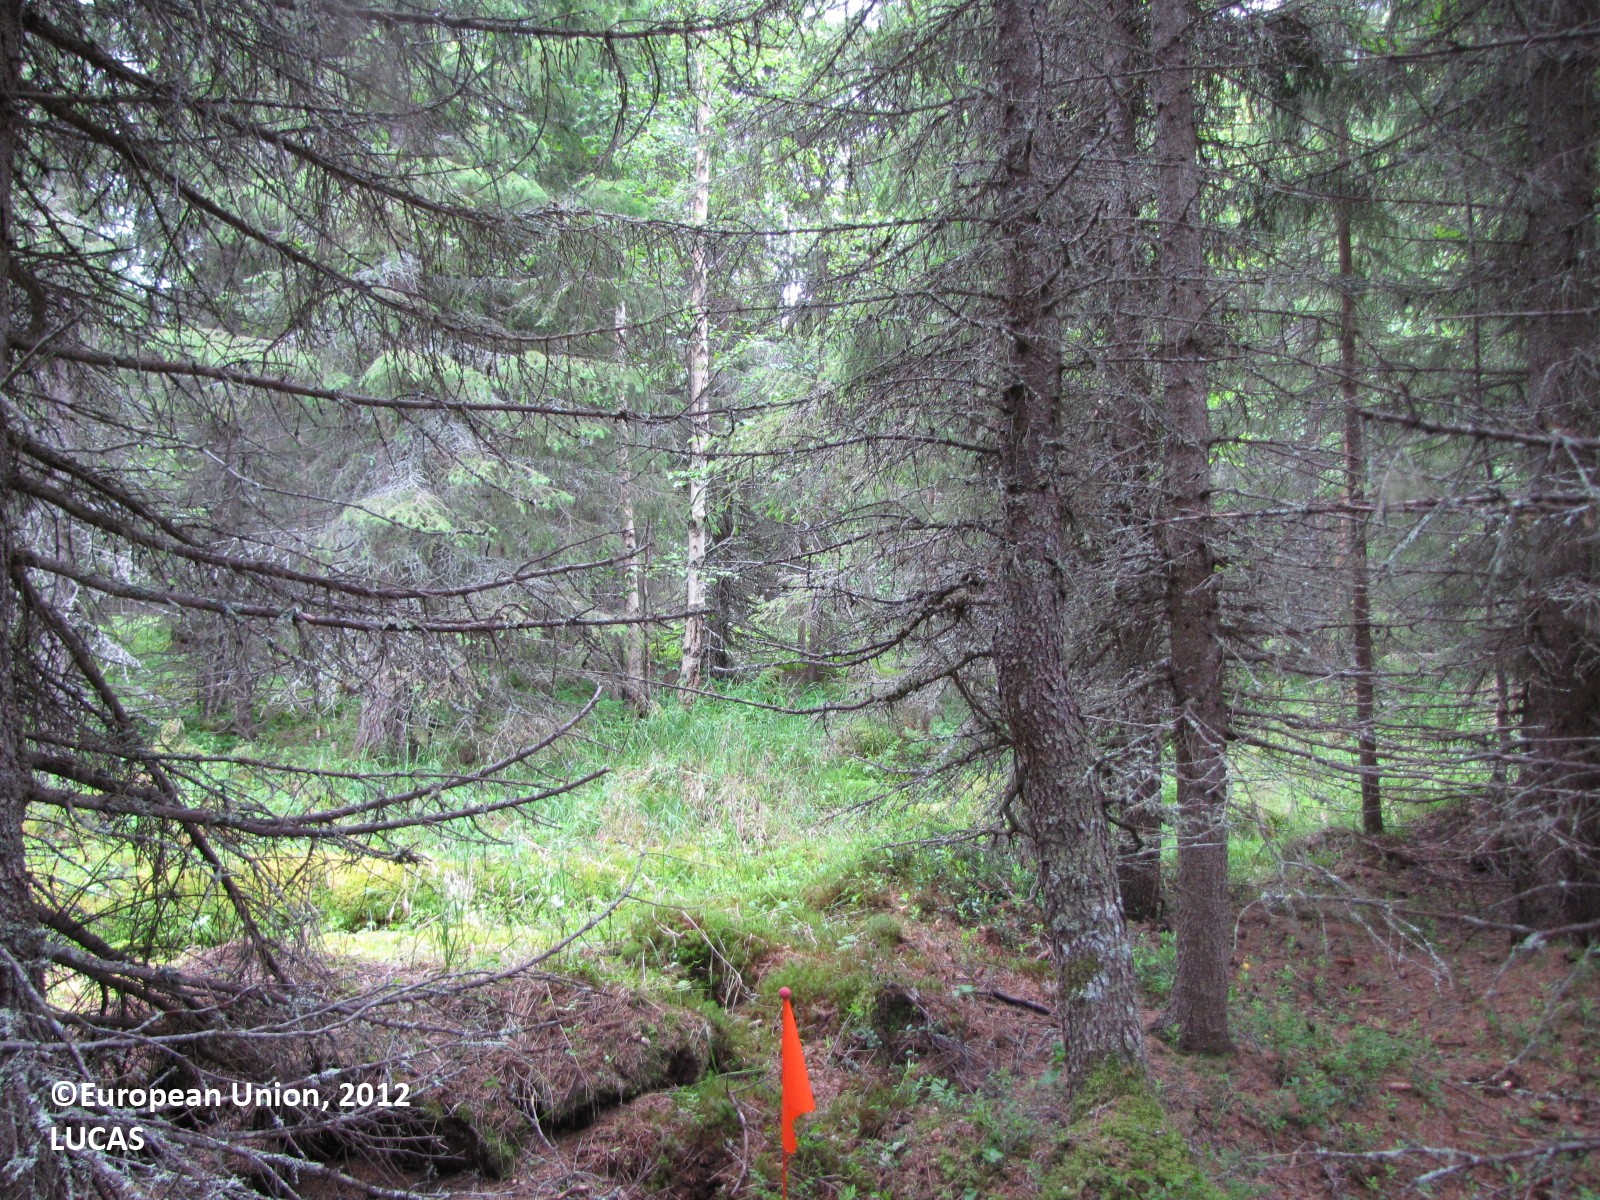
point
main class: Woodland
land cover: Spruce dominated mixed woodland
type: boreal forest
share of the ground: 50 - 75 %
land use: Forestry
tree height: > 5 m
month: July
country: FI
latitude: 66.5753
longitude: 24.8603
